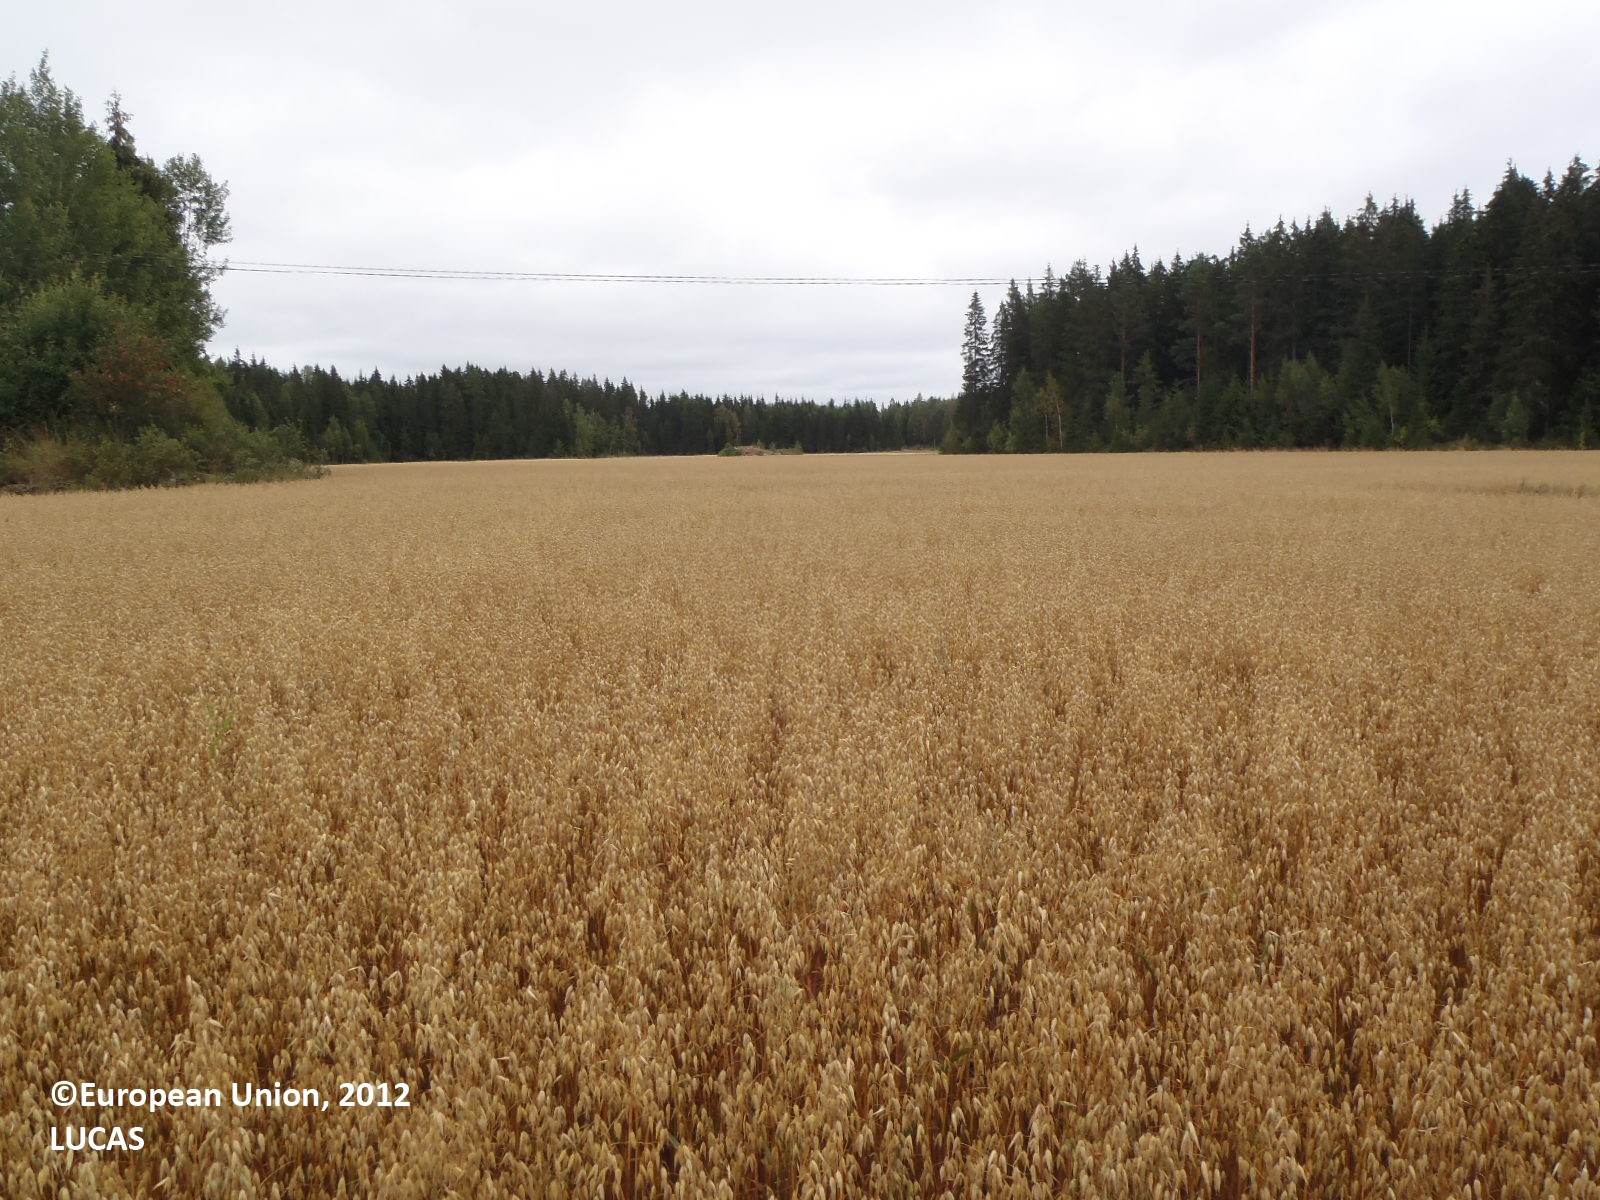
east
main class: Cropland
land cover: Oats
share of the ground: > 75 %
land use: Agriculture (excluding fallow land and kitchen gardens)
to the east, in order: Oats; Barley
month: August
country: FI
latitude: 60.7631
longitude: 21.9731
